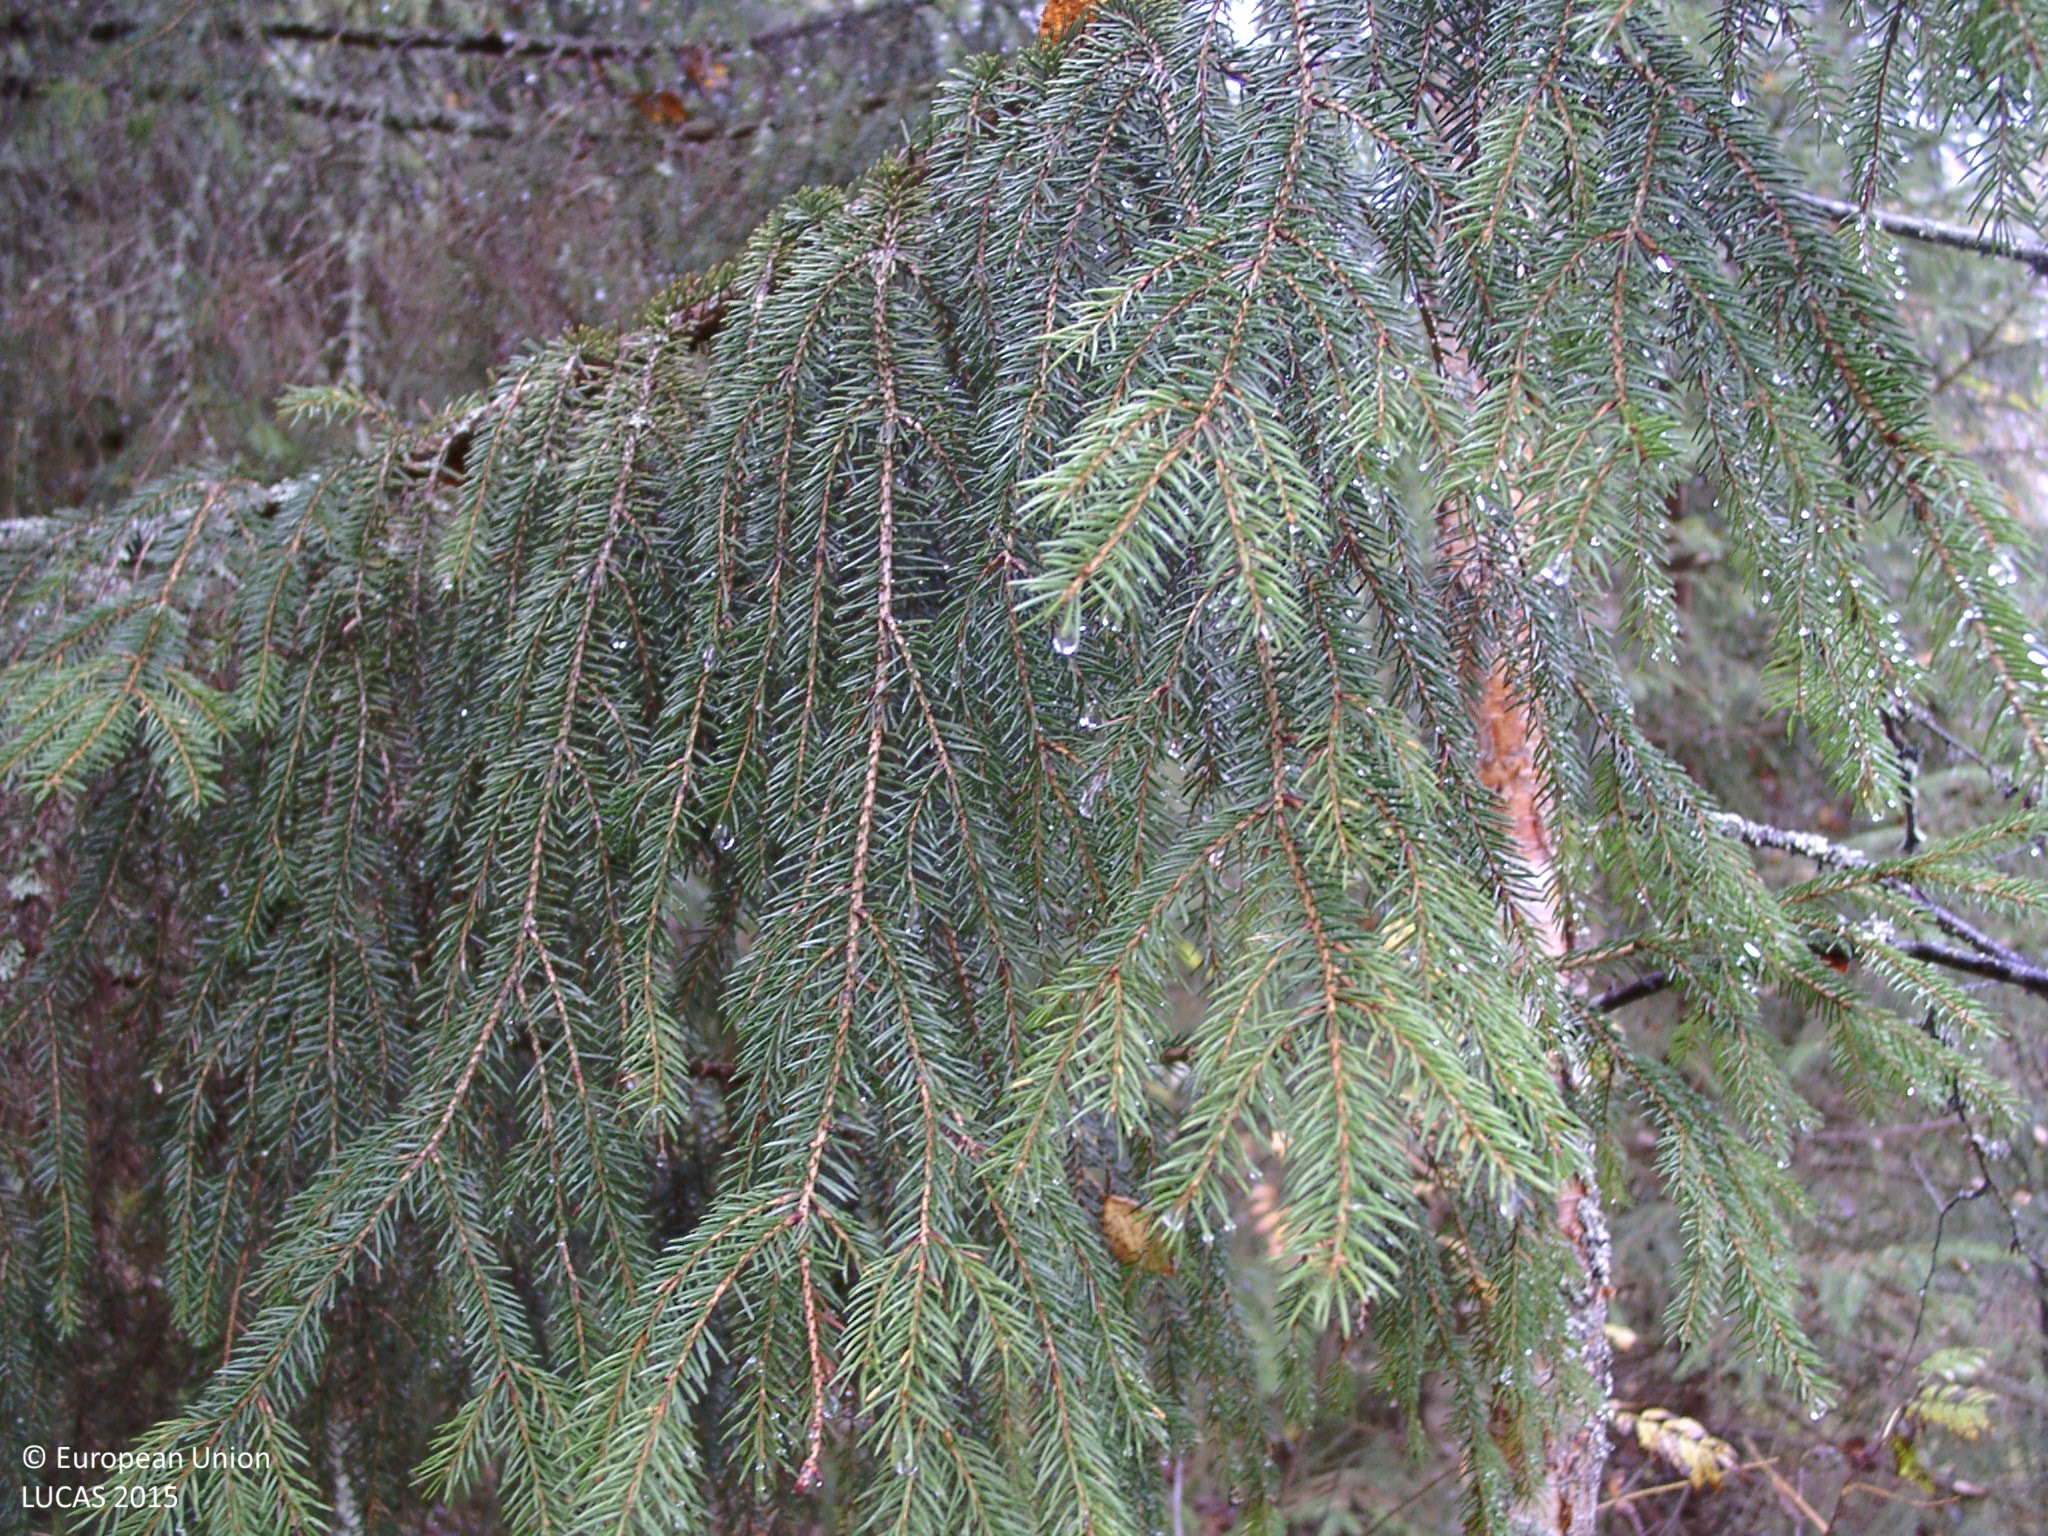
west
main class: Shrubland
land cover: Shrubland with sparse tree cover
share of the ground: 25 - 50 %
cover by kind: herbaceous plants 55 %, shrubs 40 %, broadleaved forest trees 5 %
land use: Forestry
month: September
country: FI
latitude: 62.7441
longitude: 25.3129
